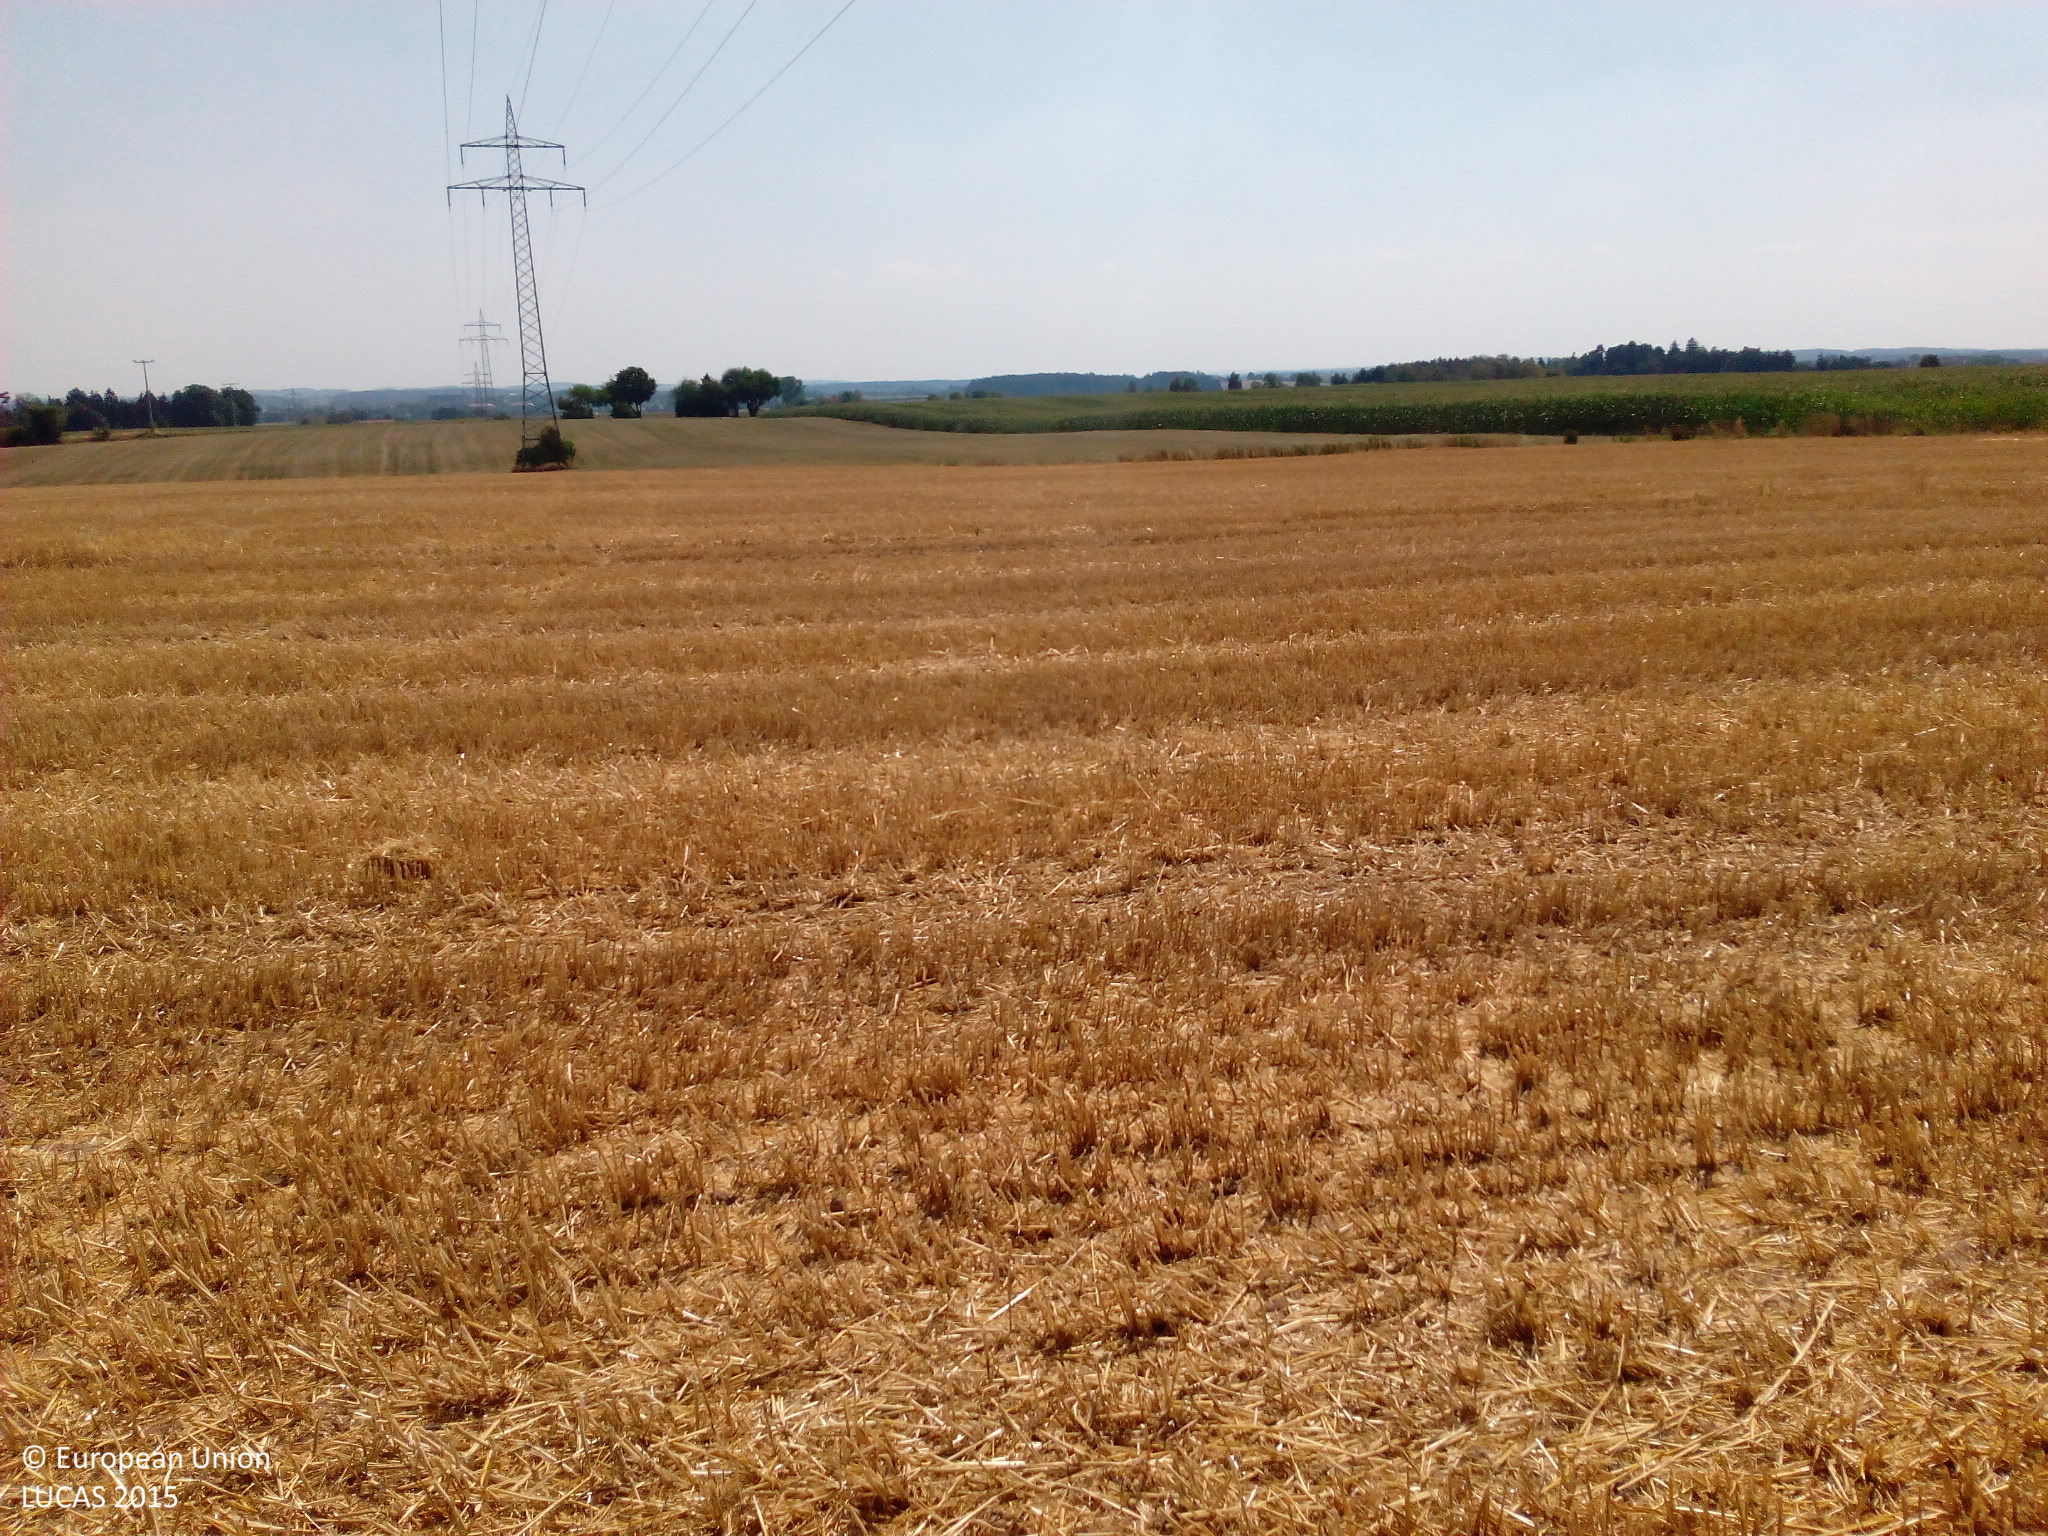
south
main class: Cropland
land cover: Common wheat
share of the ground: < 10 %
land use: Agriculture (excluding fallow land and kitchen gardens)
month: August
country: DE
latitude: 49.1047
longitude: 10.3149
